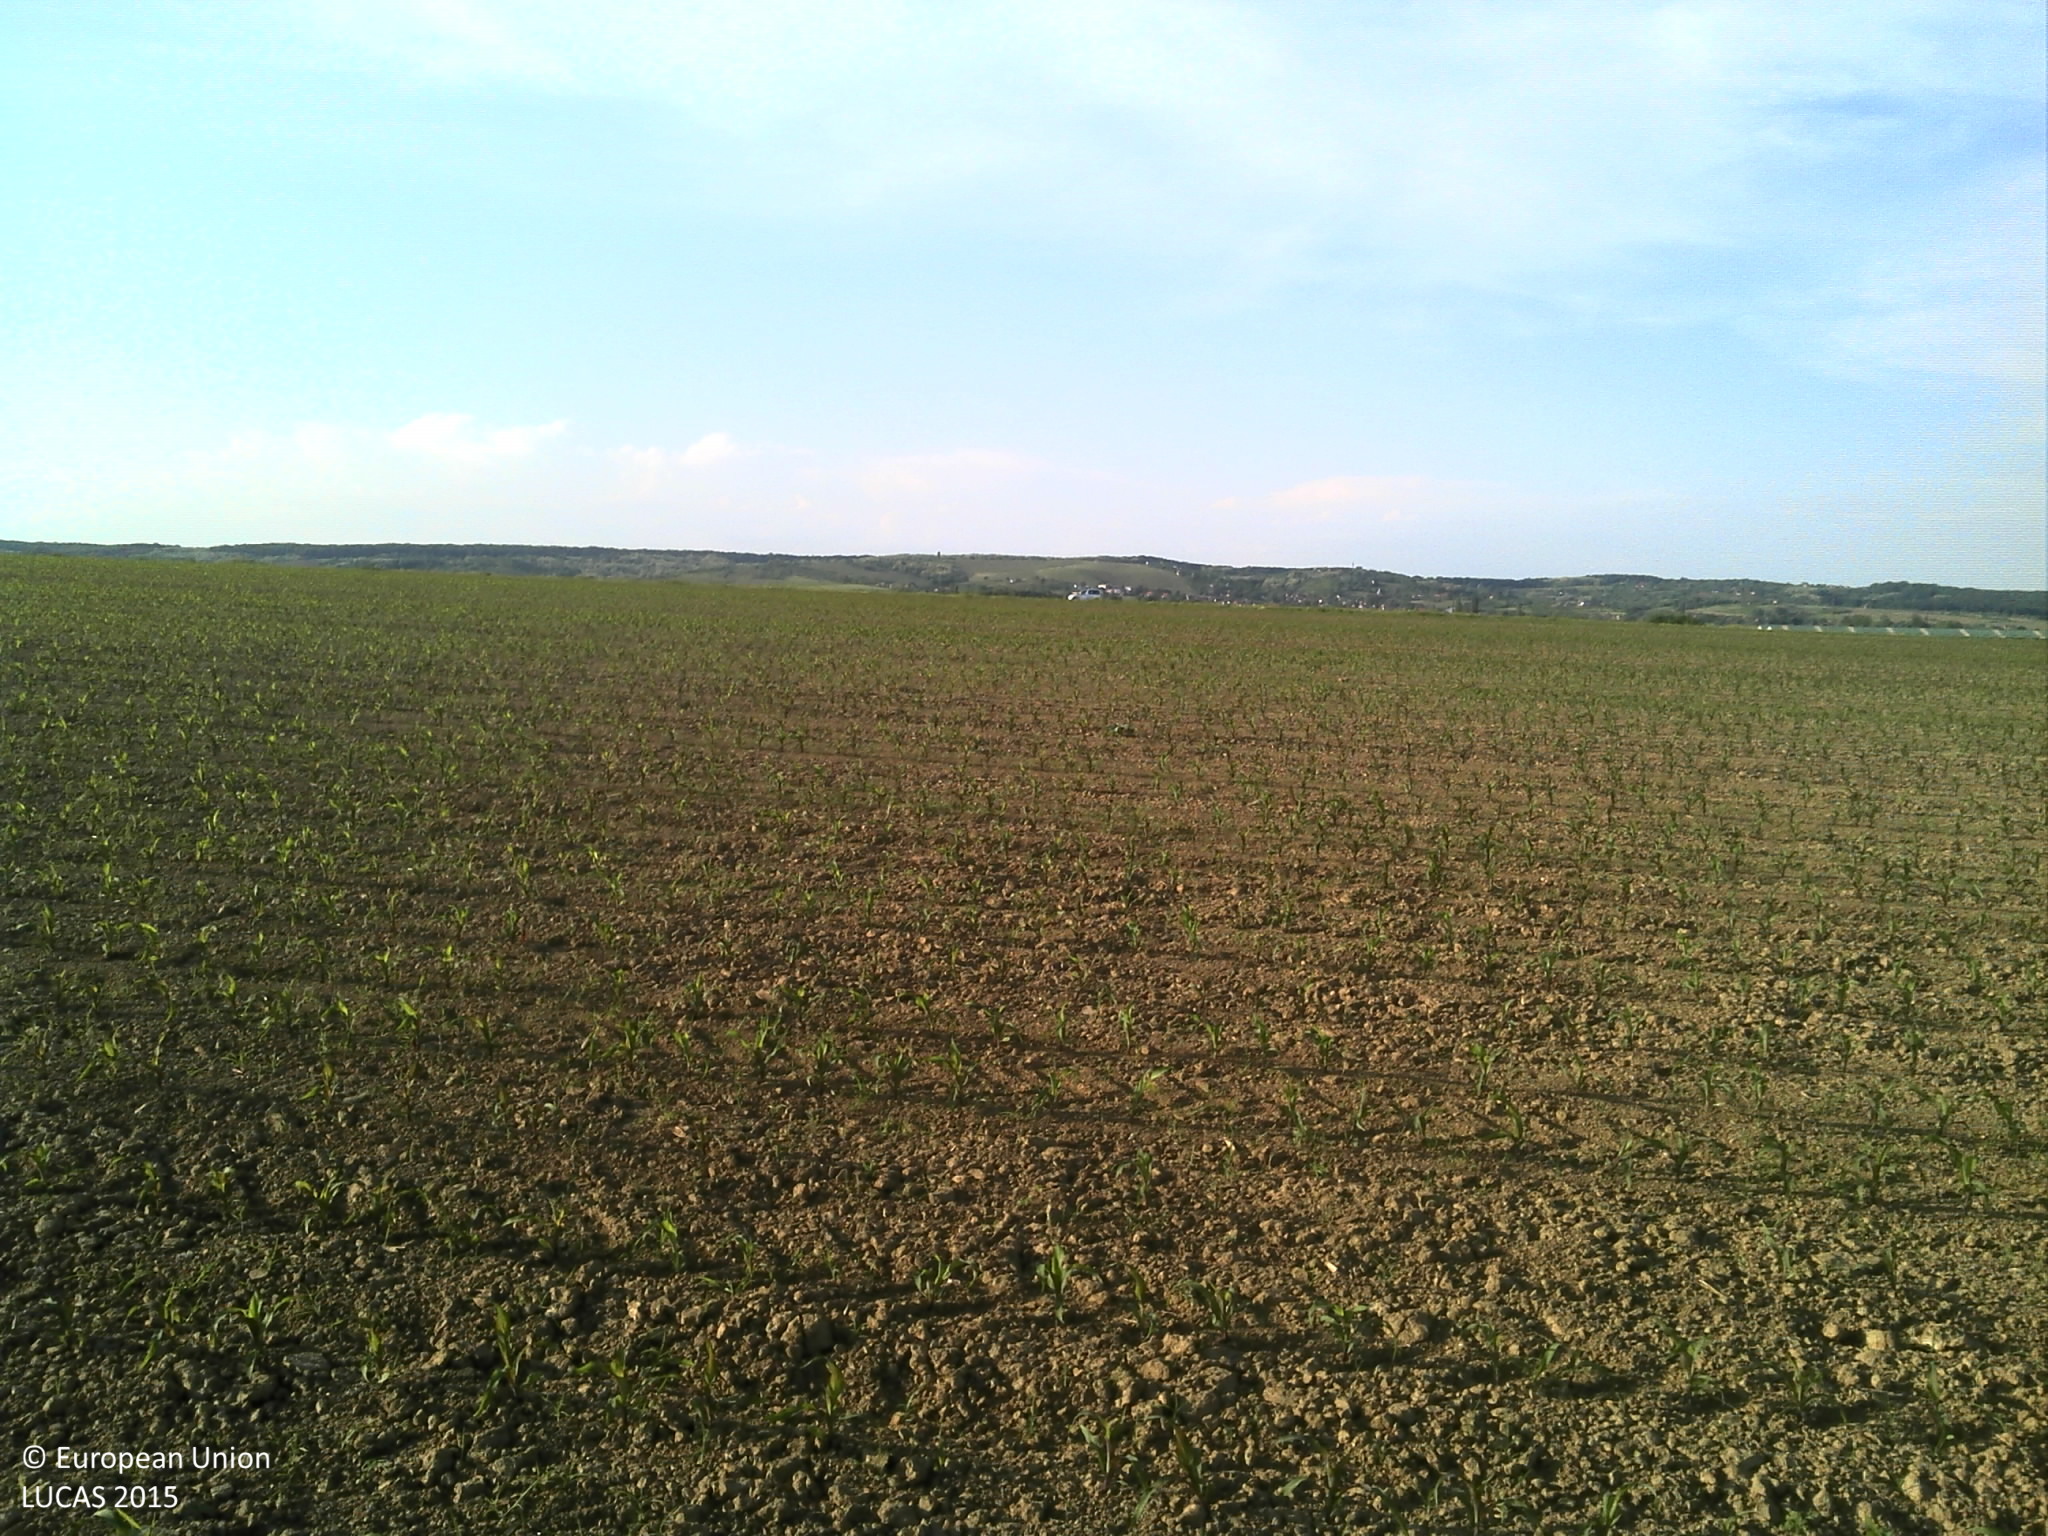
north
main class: Cropland
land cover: Maize
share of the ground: < 10 %
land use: Agriculture (excluding fallow land and kitchen gardens)
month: May
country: HR
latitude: 45.2358
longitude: 18.2455
